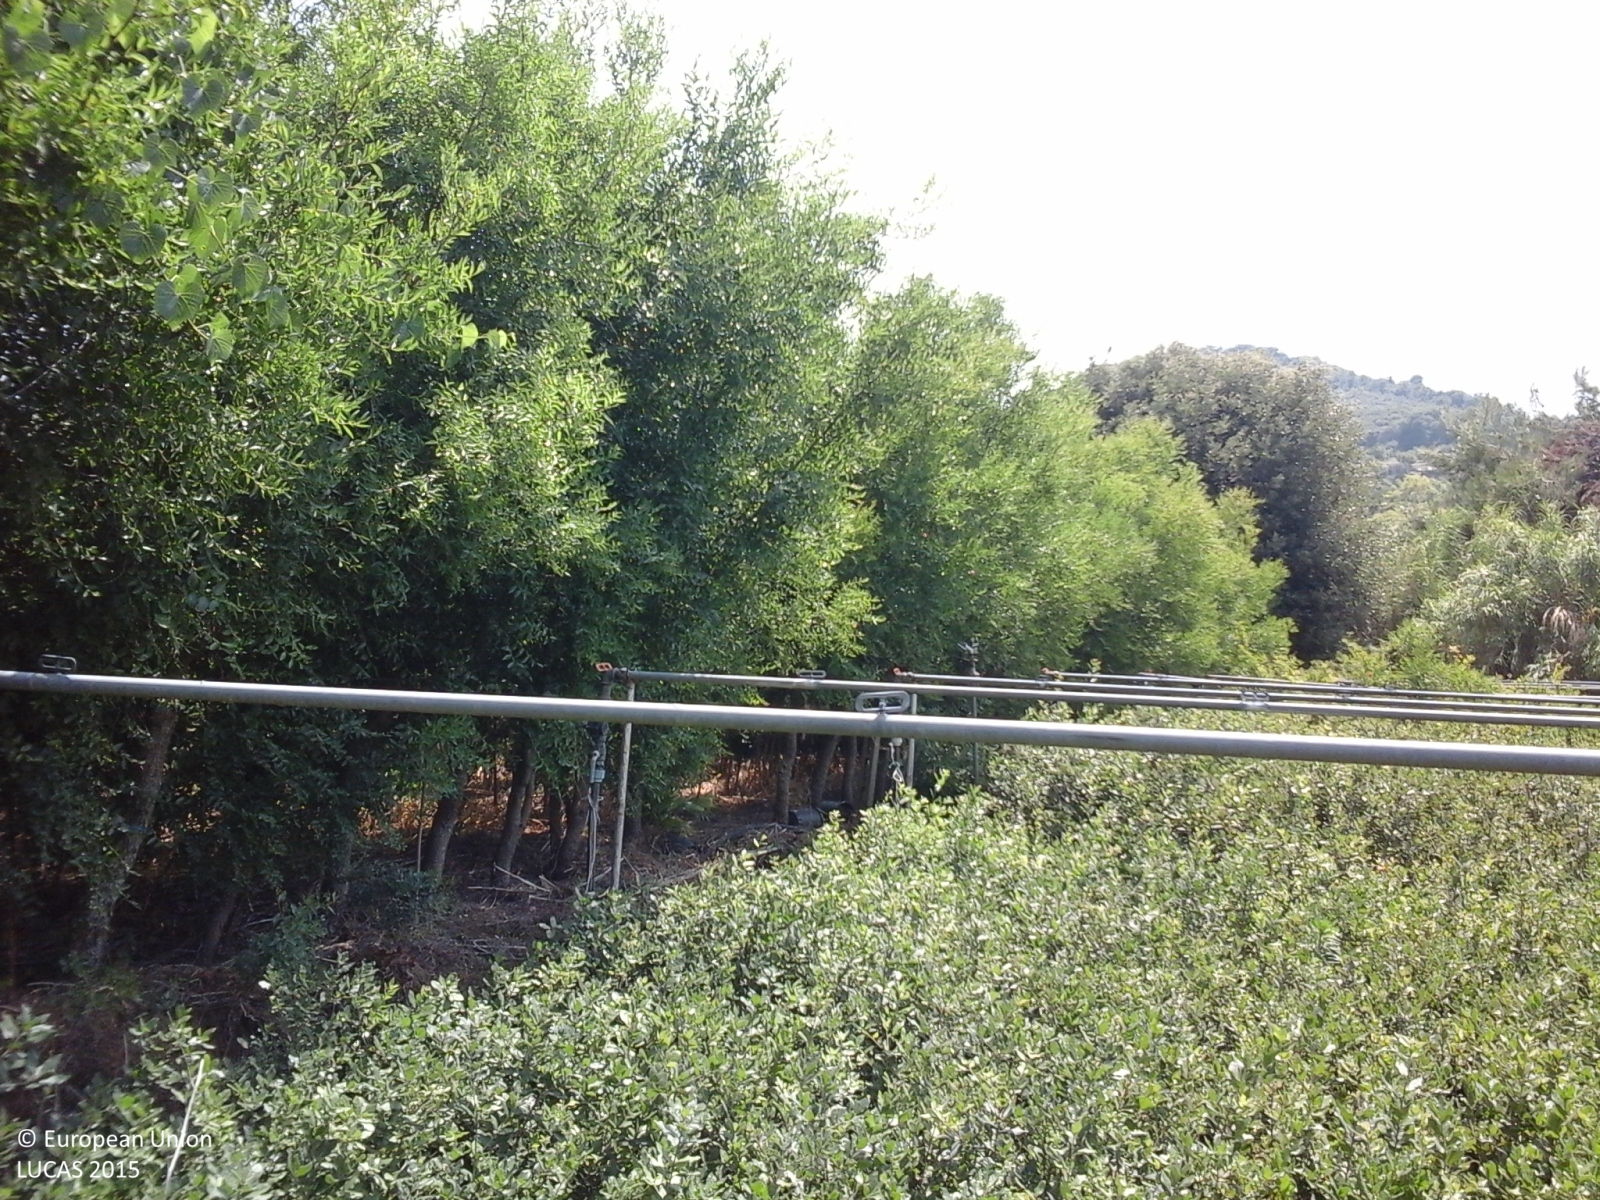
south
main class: Cropland
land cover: Nurseries
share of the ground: > 75 %
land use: Agriculture (excluding fallow land and kitchen gardens)
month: July
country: IT
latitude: 43.0344
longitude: 13.8070
